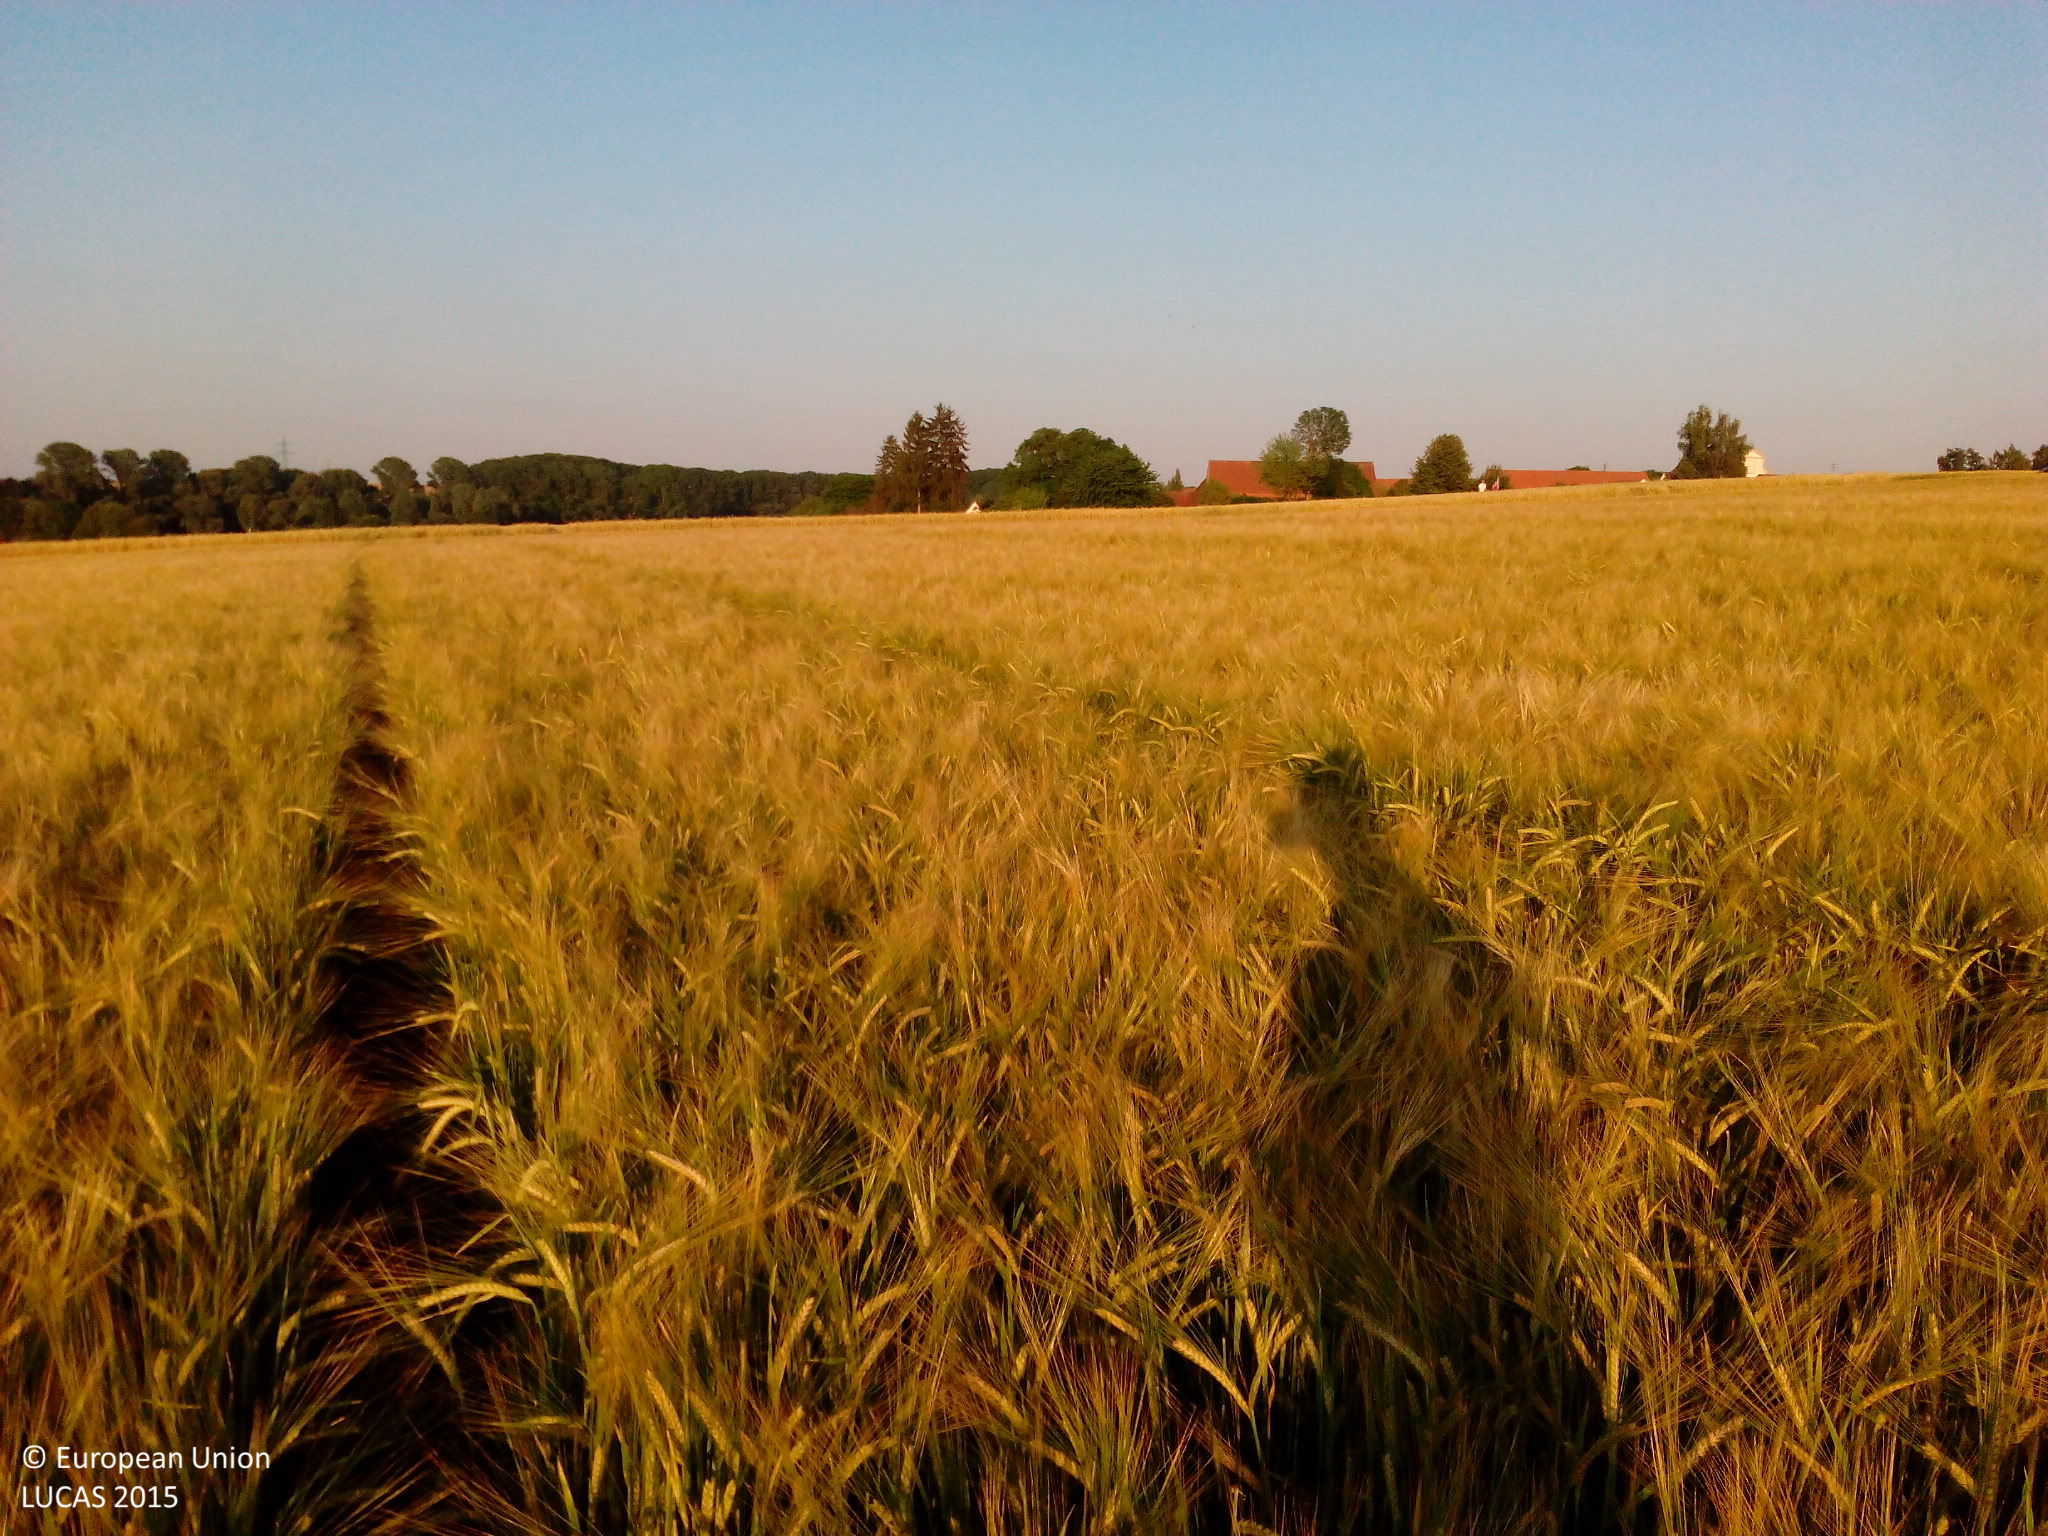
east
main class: Cropland
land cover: Barley
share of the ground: > 75 %
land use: Agriculture (excluding fallow land and kitchen gardens)
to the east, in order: Barley; Tracks; Barley
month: July
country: DE
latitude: 49.6087
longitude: 9.9032
